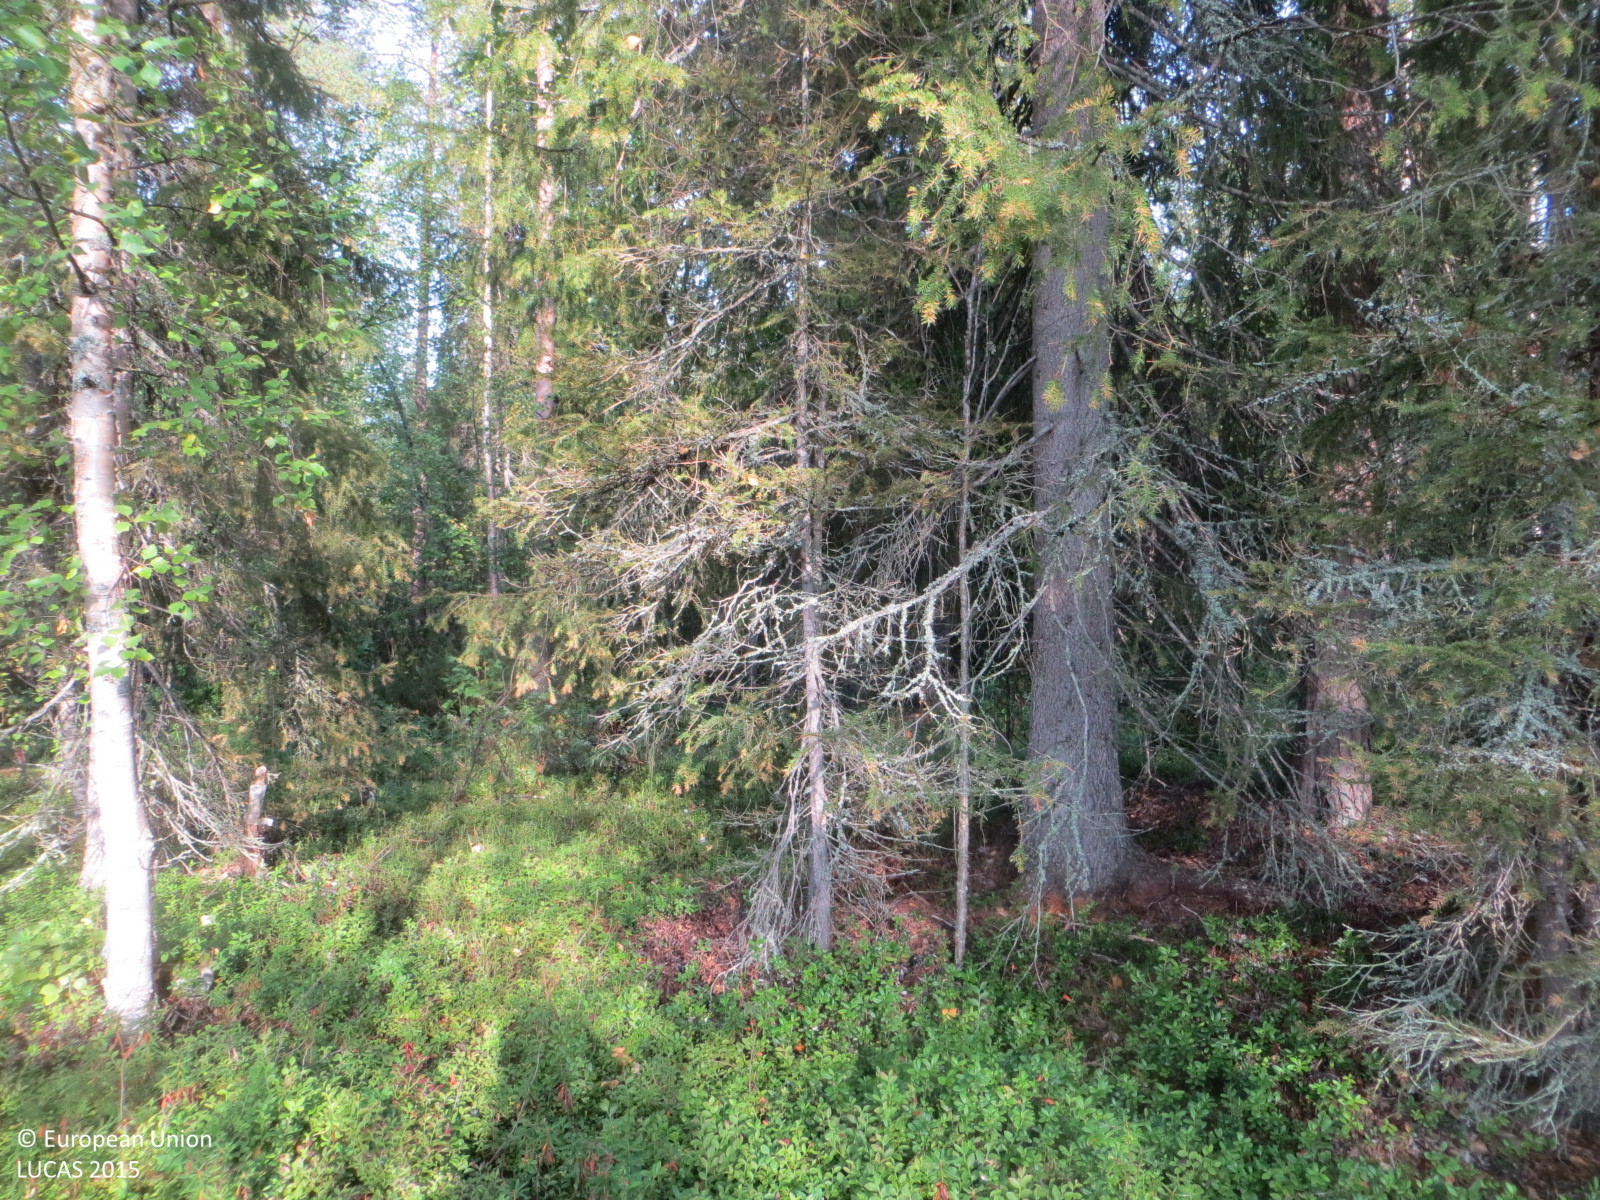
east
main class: Woodland
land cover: Other mixed woodland
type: boreal forest
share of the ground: 50 - 75 %
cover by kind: shrubs 40 %, coniferous forest trees 30 %, broadleaved forest trees 30 %
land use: Forestry
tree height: > 5 m
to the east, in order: Other mixed woodland; Tracks; Spruce dominated mixed woodland; Ditches and canals; Spruce dominated mixed woodland; Grass margins; Ditches and canals; Grass margins; Paved roads, cycling and walking lanes; Grass margins; Ditches and canals; Grassland without tree/shrub cover; Paved roads, cycling and walking lanes; Grass margins; Spruce dominated mixed woodland
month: August
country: FI
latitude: 67.7948
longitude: 24.9000
